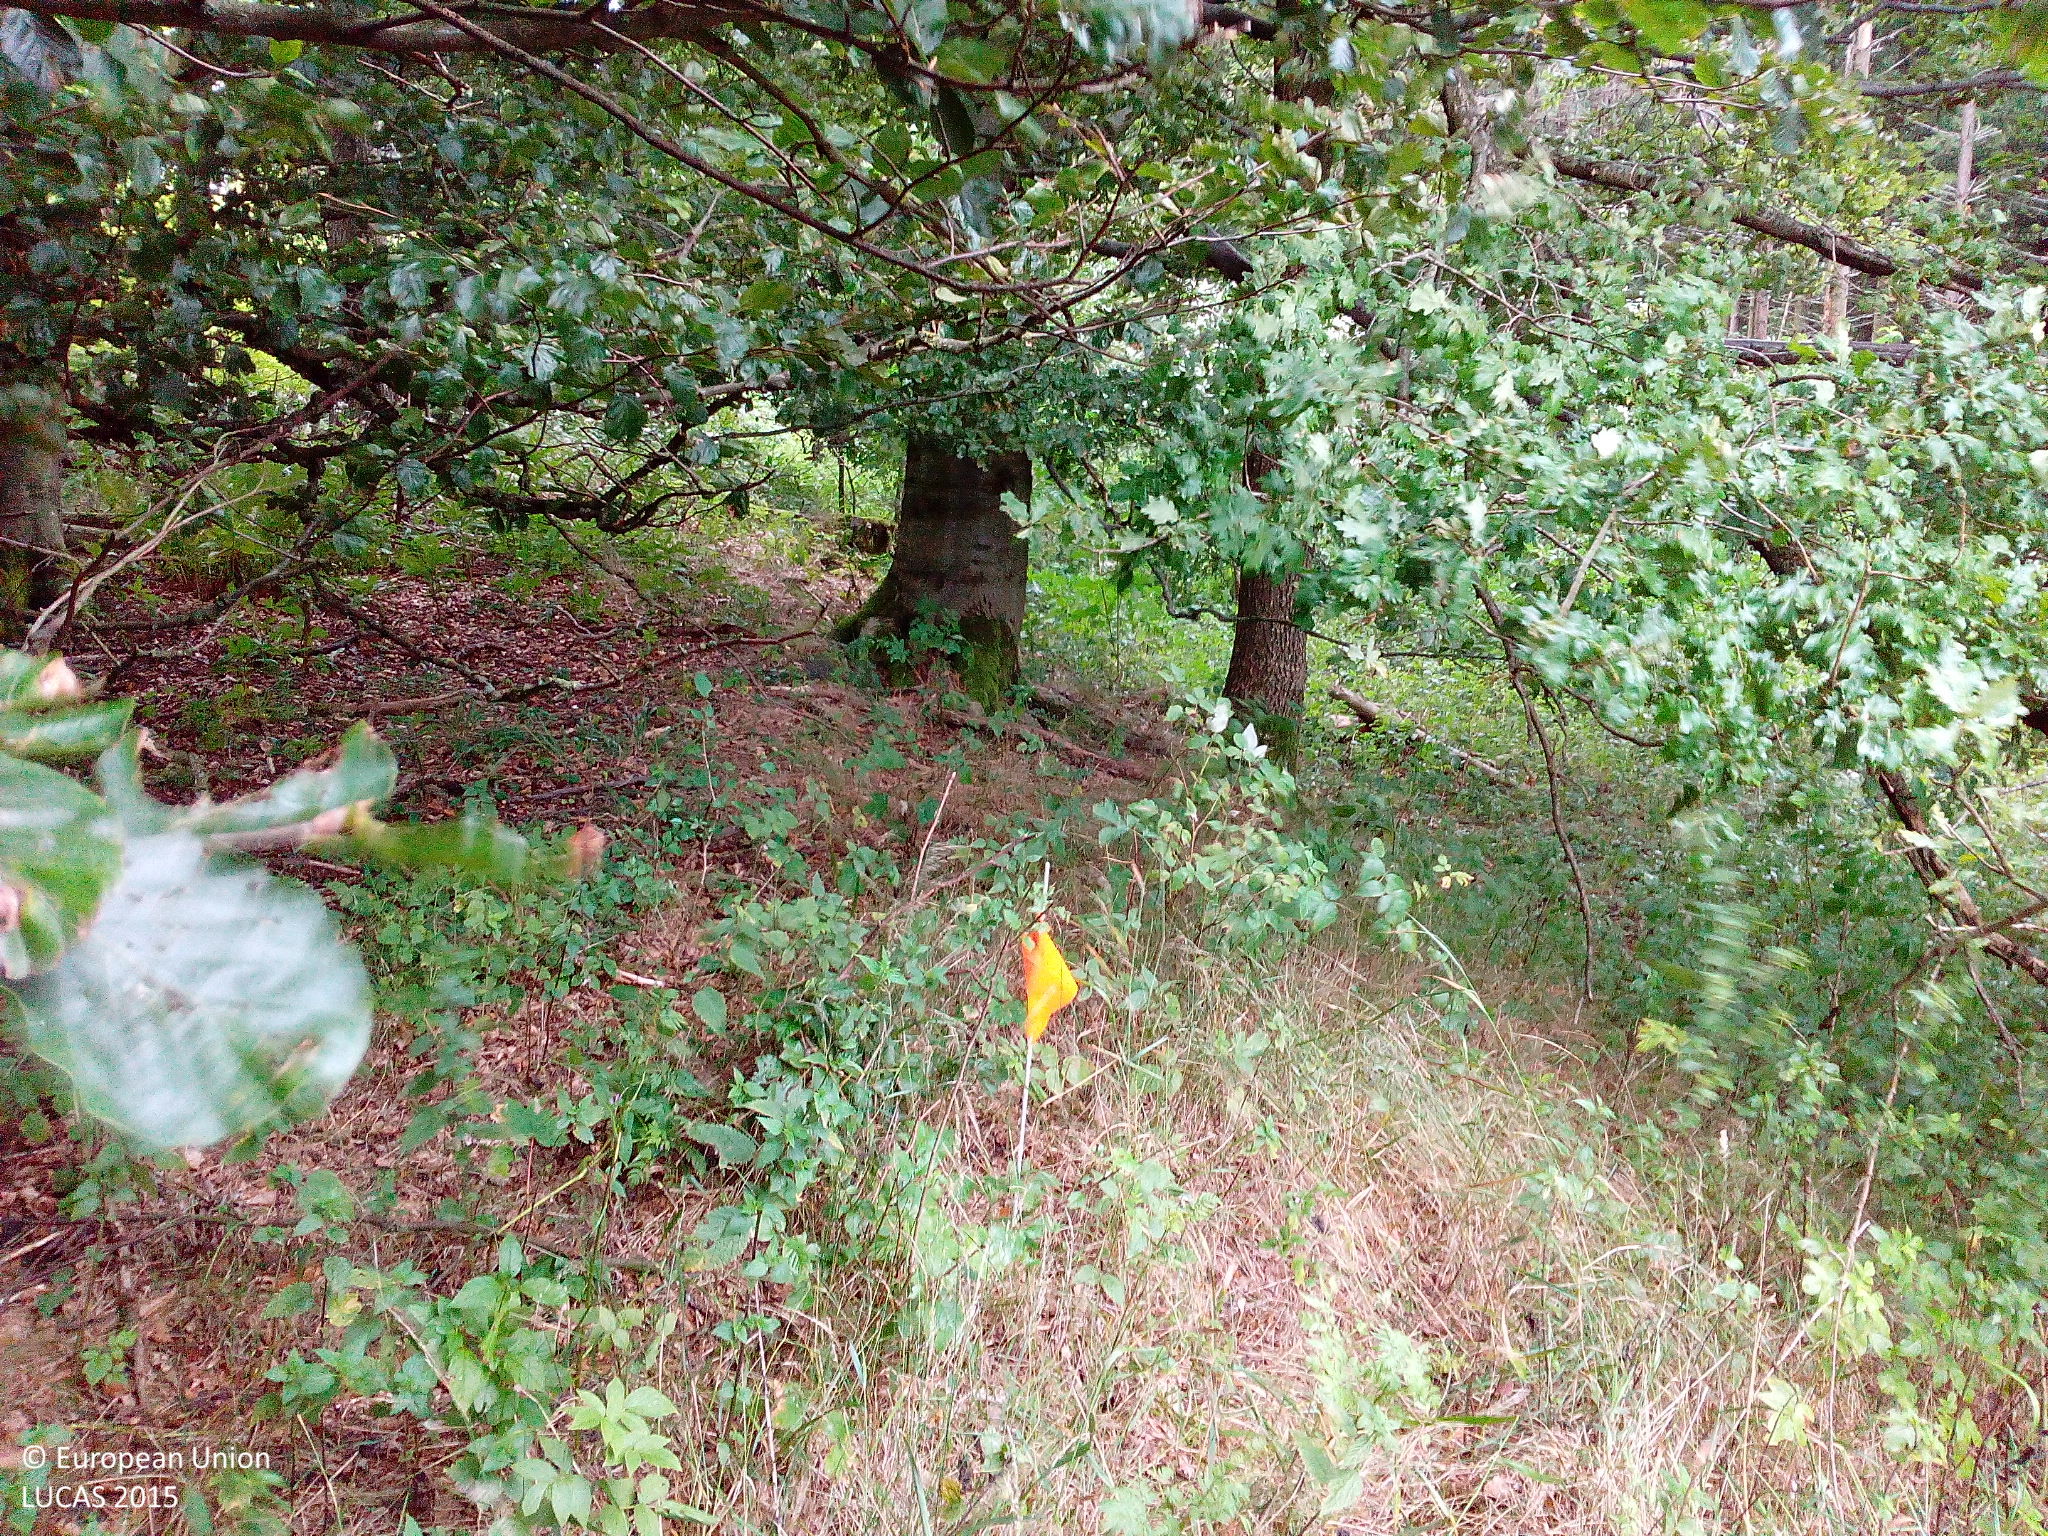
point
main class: Woodland
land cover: Spruce dominated mixed woodland
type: hemiboreal forest and nemoral coniferous forest and mixed broadleaved-coniferous forest
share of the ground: > 75 %
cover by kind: broadleaved forest trees 70 %, coniferous forest trees 30 %
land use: Forestry
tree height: > 5 m
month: August
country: DE
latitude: 50.5590
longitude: 9.1956
